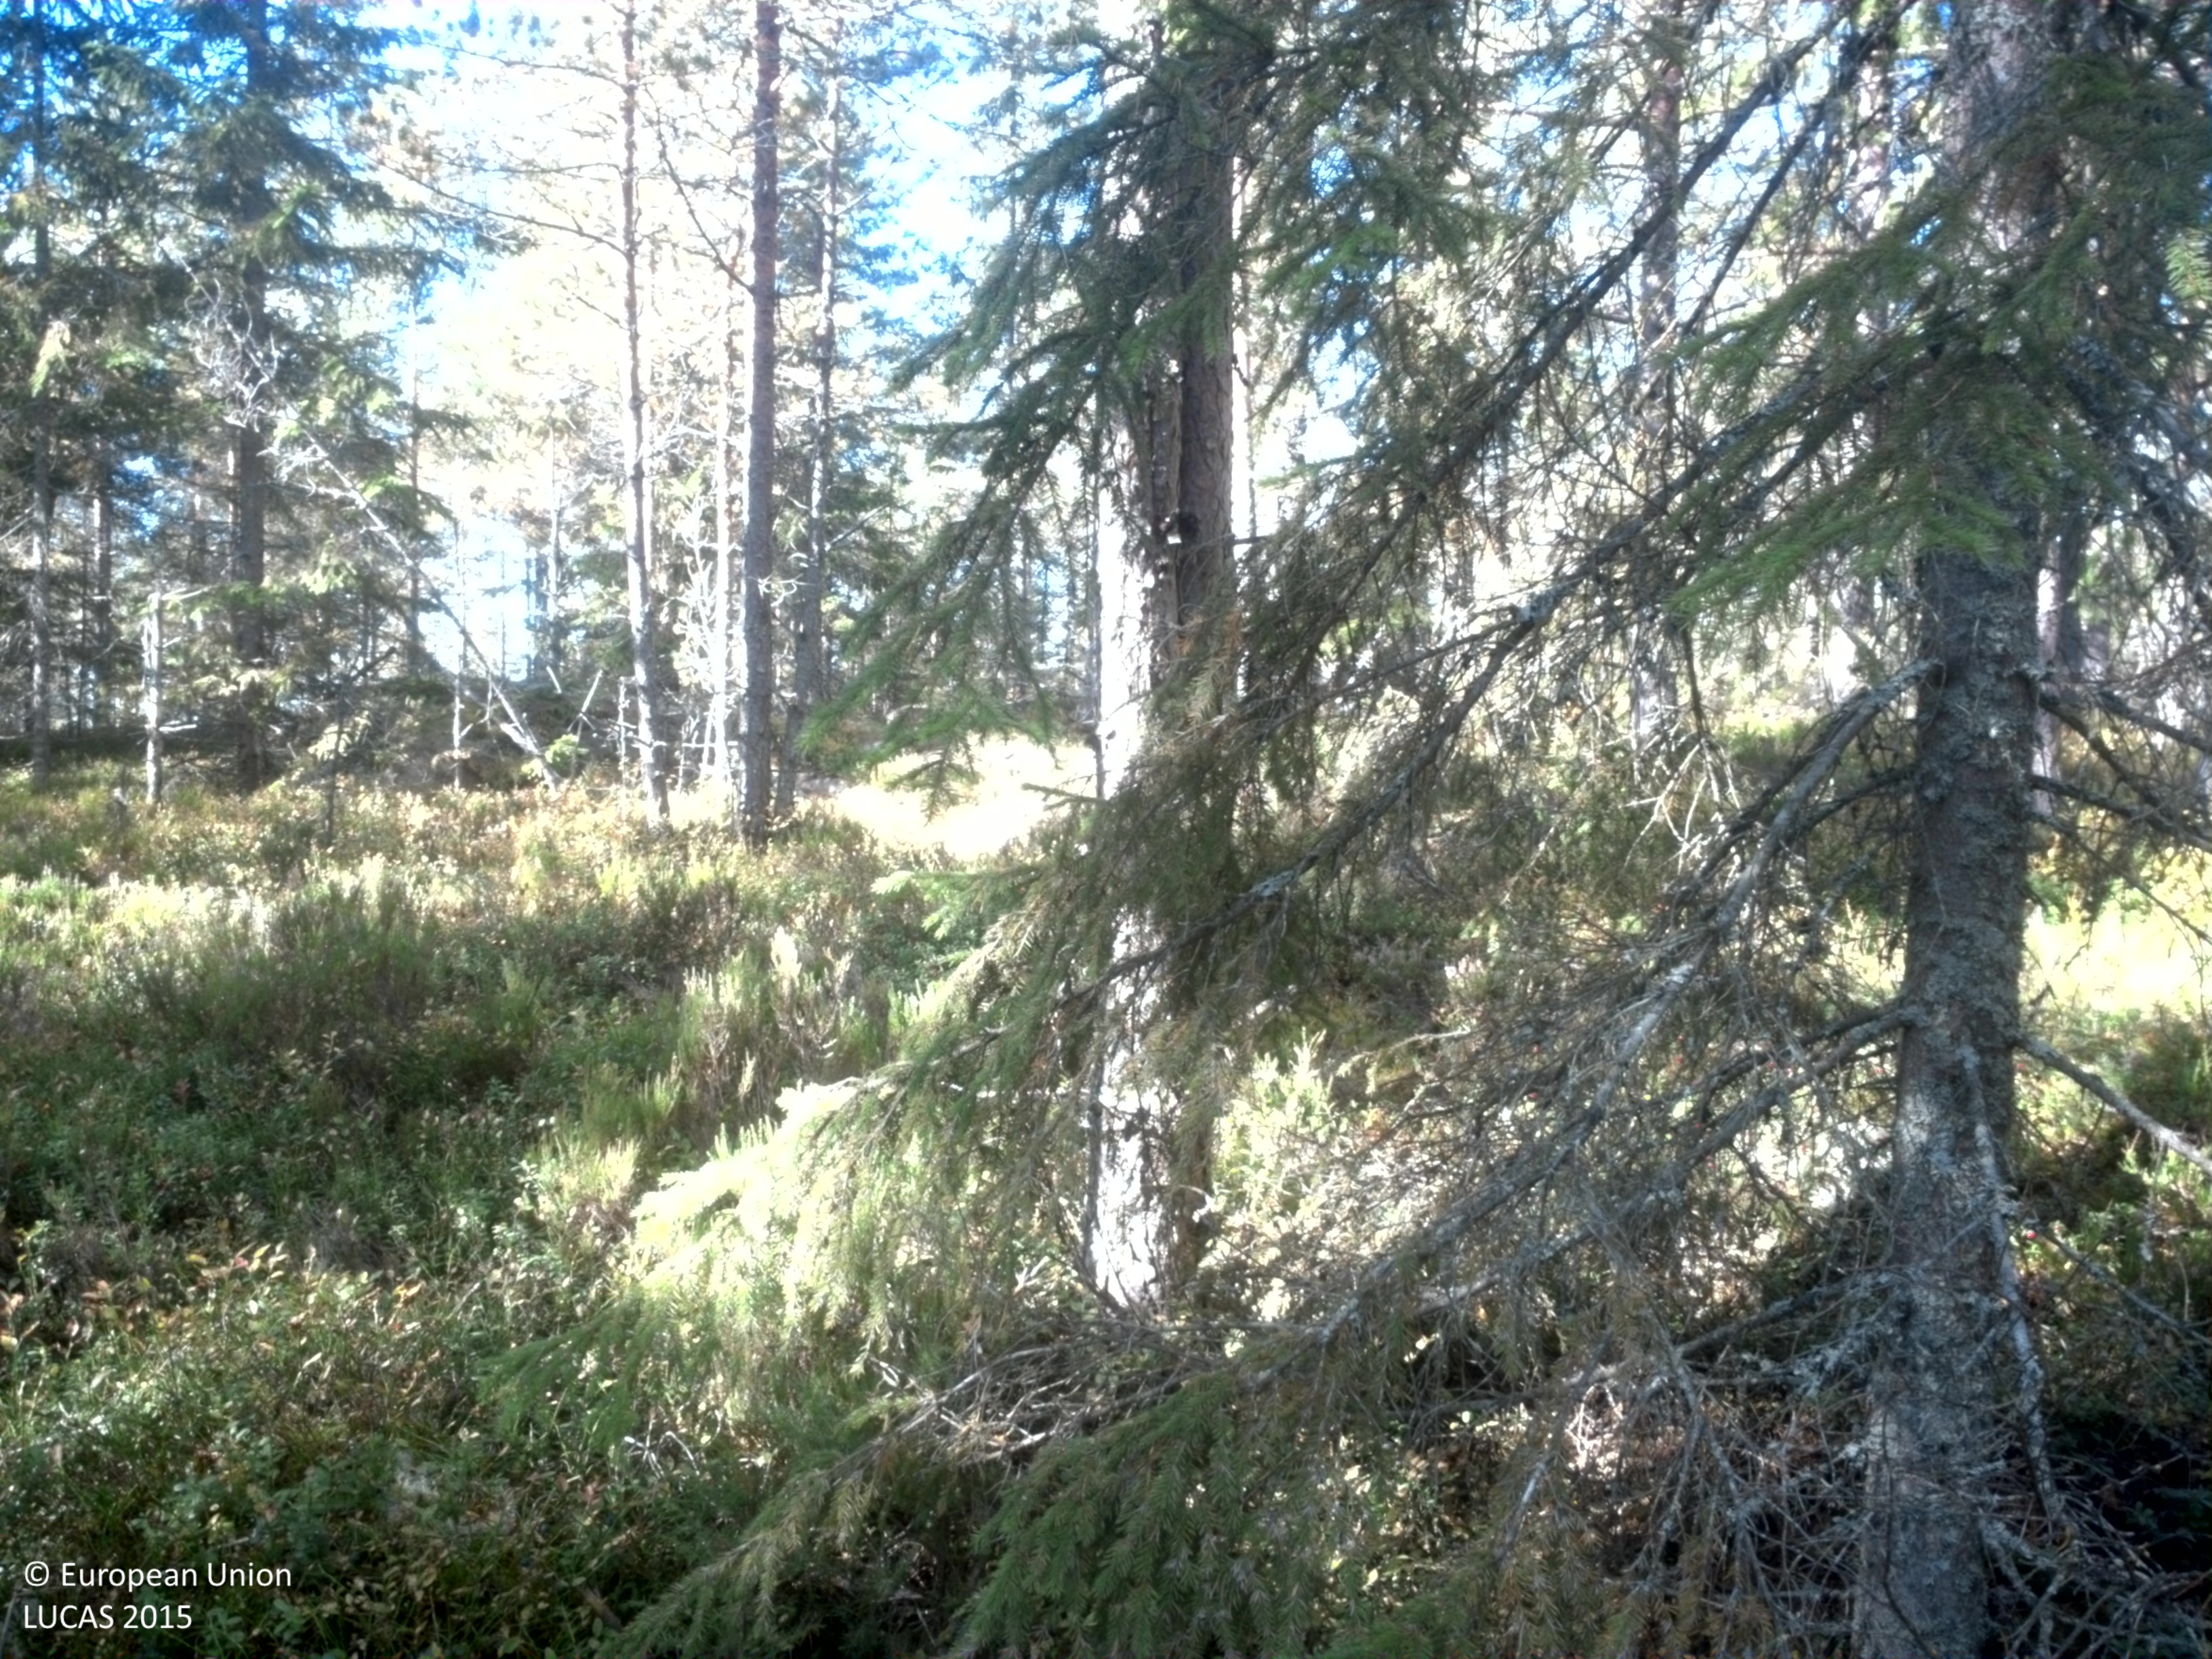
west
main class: Woodland
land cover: Other coniferous woodland
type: boreal forest
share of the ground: > 75 %
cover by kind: coniferous forest trees 75 %, shrubs 20 %, lichens and mosses 5 %
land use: Forestry
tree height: > 5 m
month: September
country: SE
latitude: 59.8688
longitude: 15.1869
